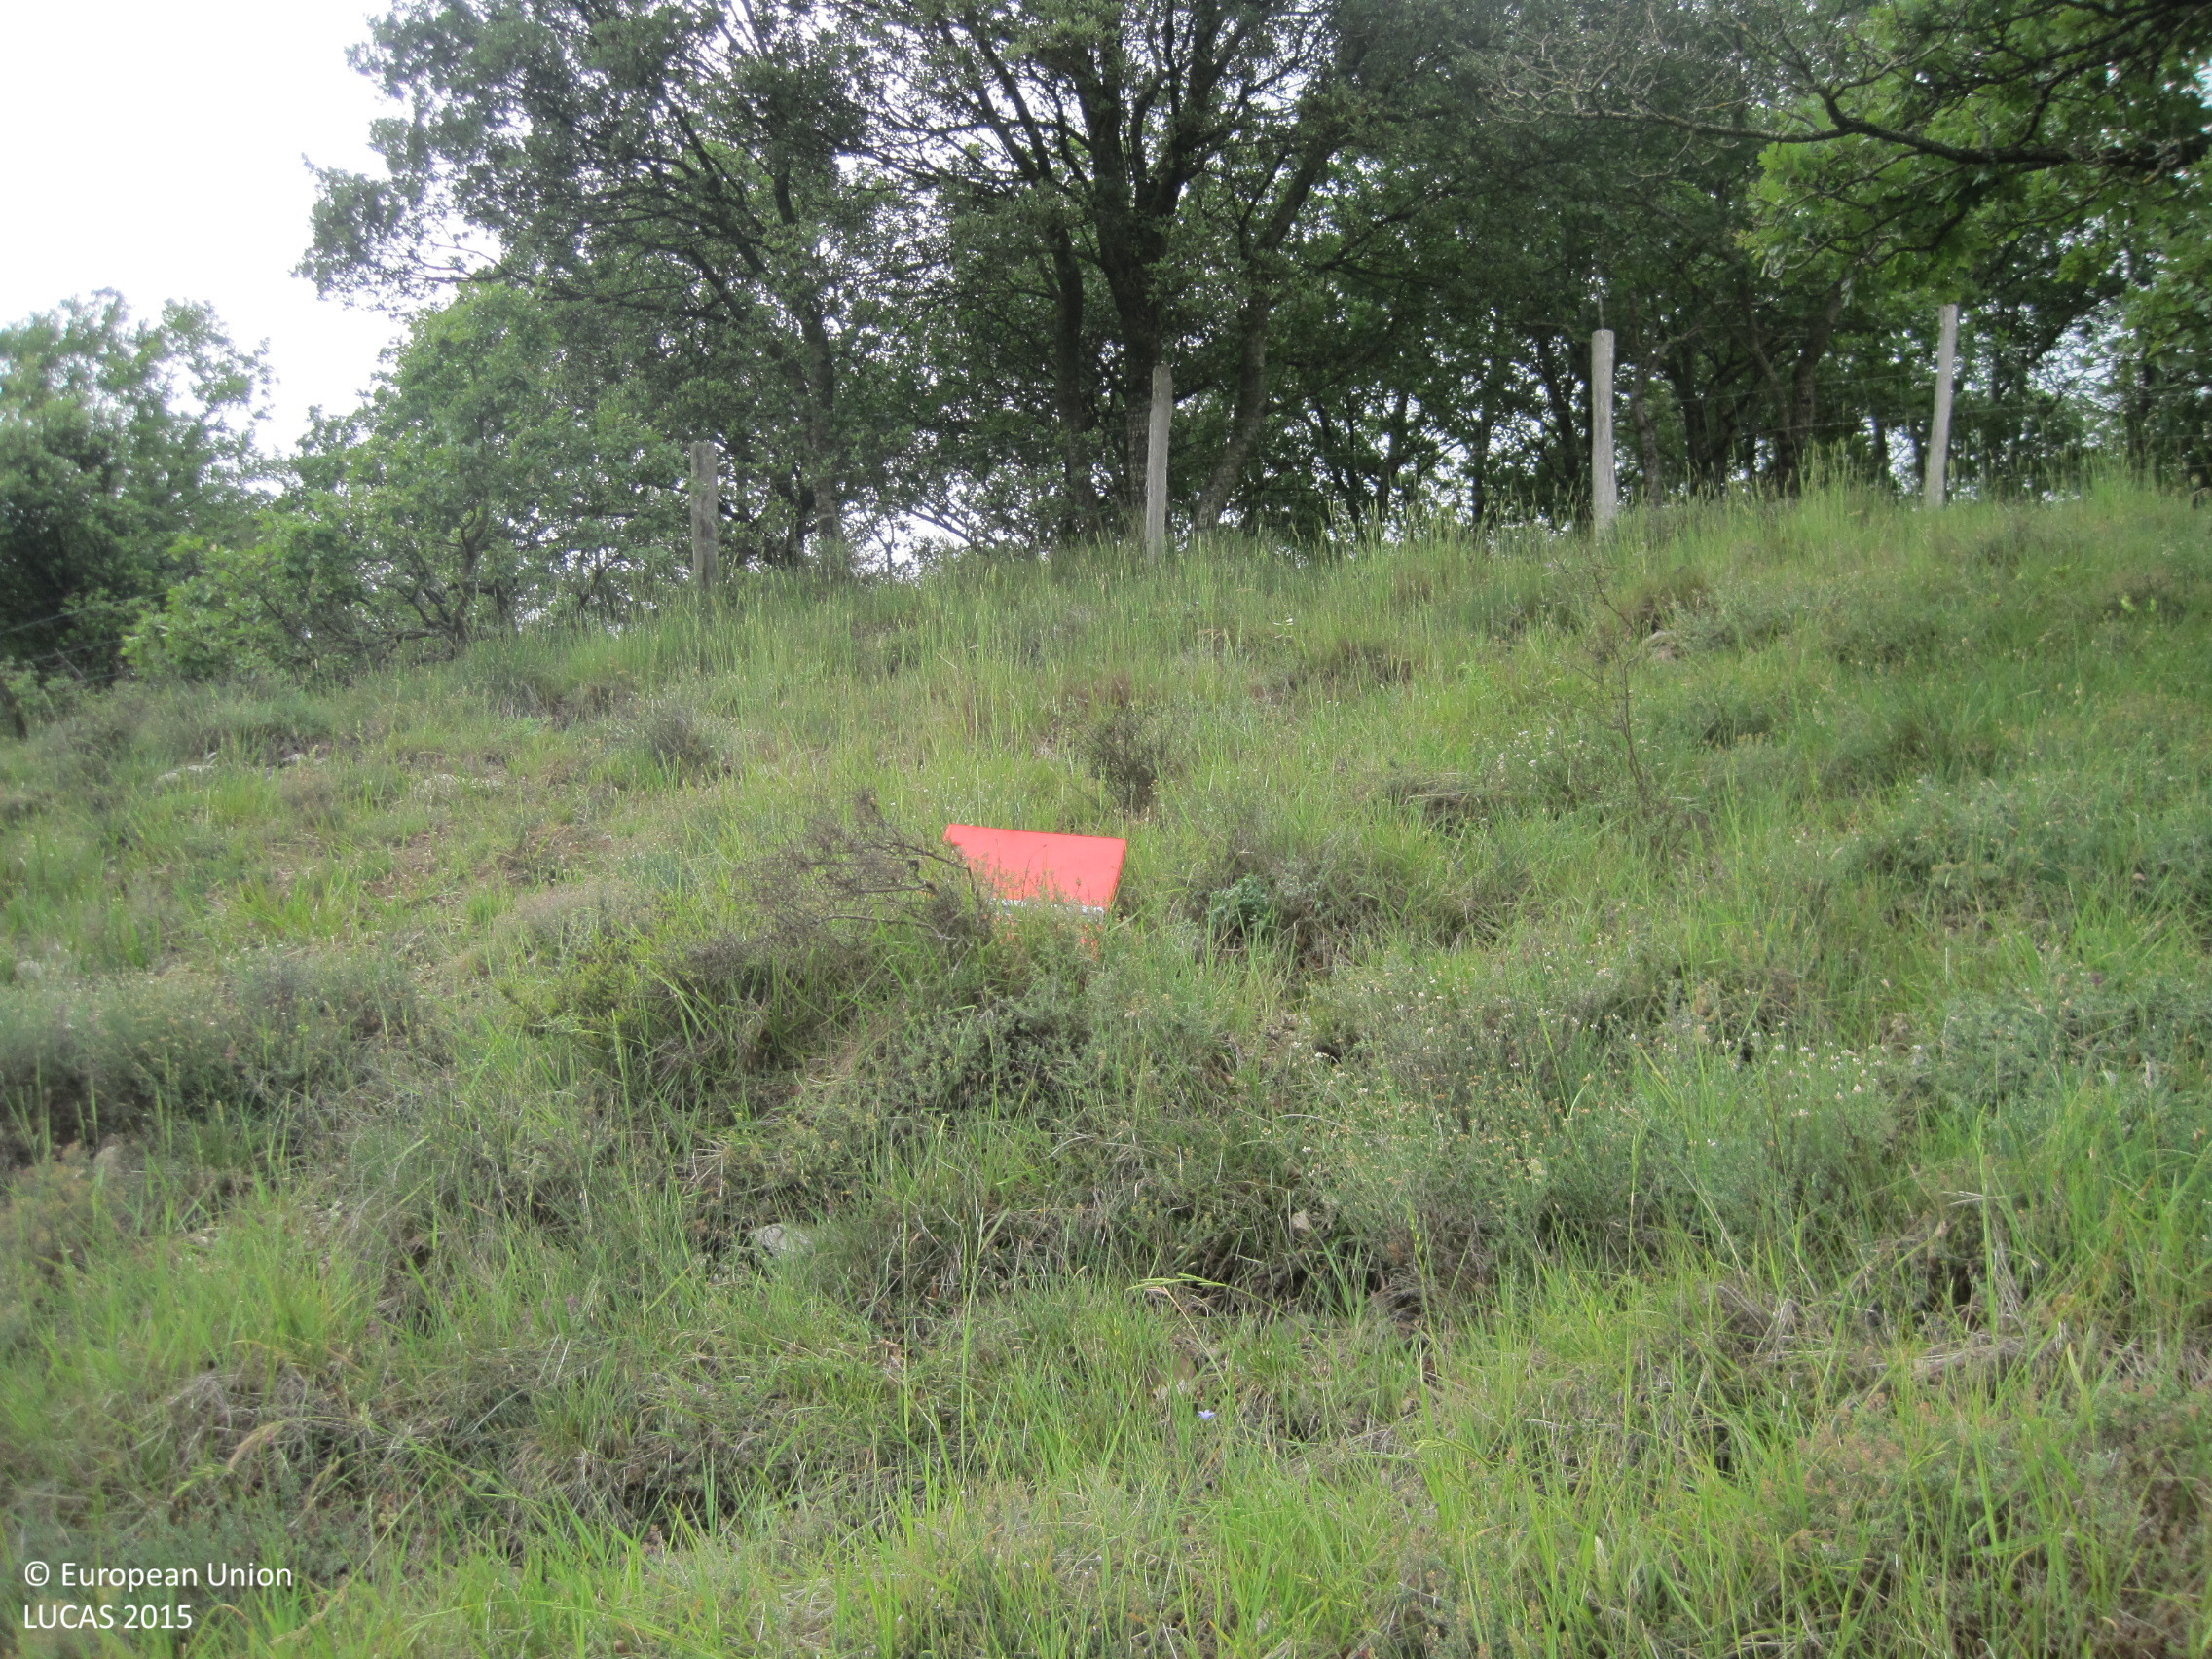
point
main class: Grassland
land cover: Grassland with sparse tree/shrub cover
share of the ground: > 75 %
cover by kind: herbaceous plants 95 %, broadleaved forest trees 5 %
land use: Agriculture (excluding fallow land and kitchen gardens)
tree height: < 5 m
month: June
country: ES
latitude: 42.8960
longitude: -1.7605
